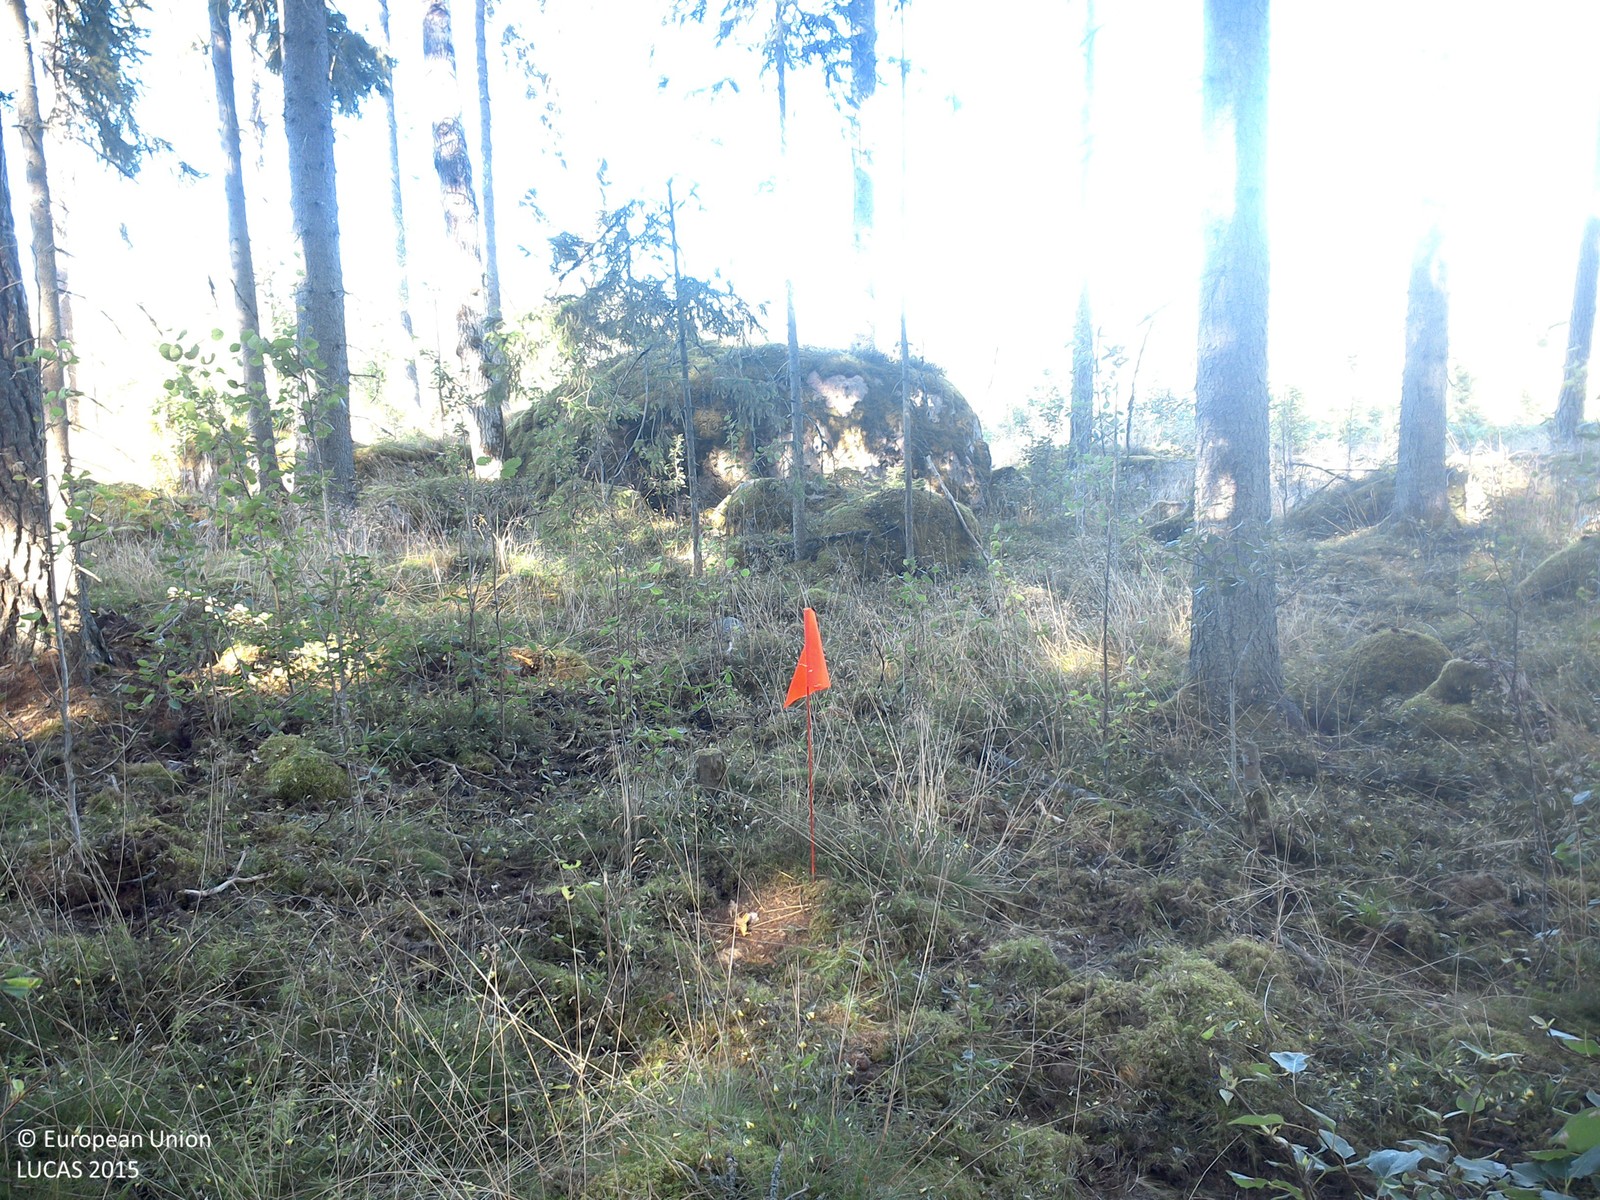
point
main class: Woodland
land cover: Spruce dominated coniferous woodland
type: boreal forest
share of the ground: 50 - 75 %
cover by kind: coniferous forest trees 55 %, lichens and mosses 45 %
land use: Forestry
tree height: > 5 m
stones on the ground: < 10 %
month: August
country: SE
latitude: 58.2236
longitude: 15.2896
